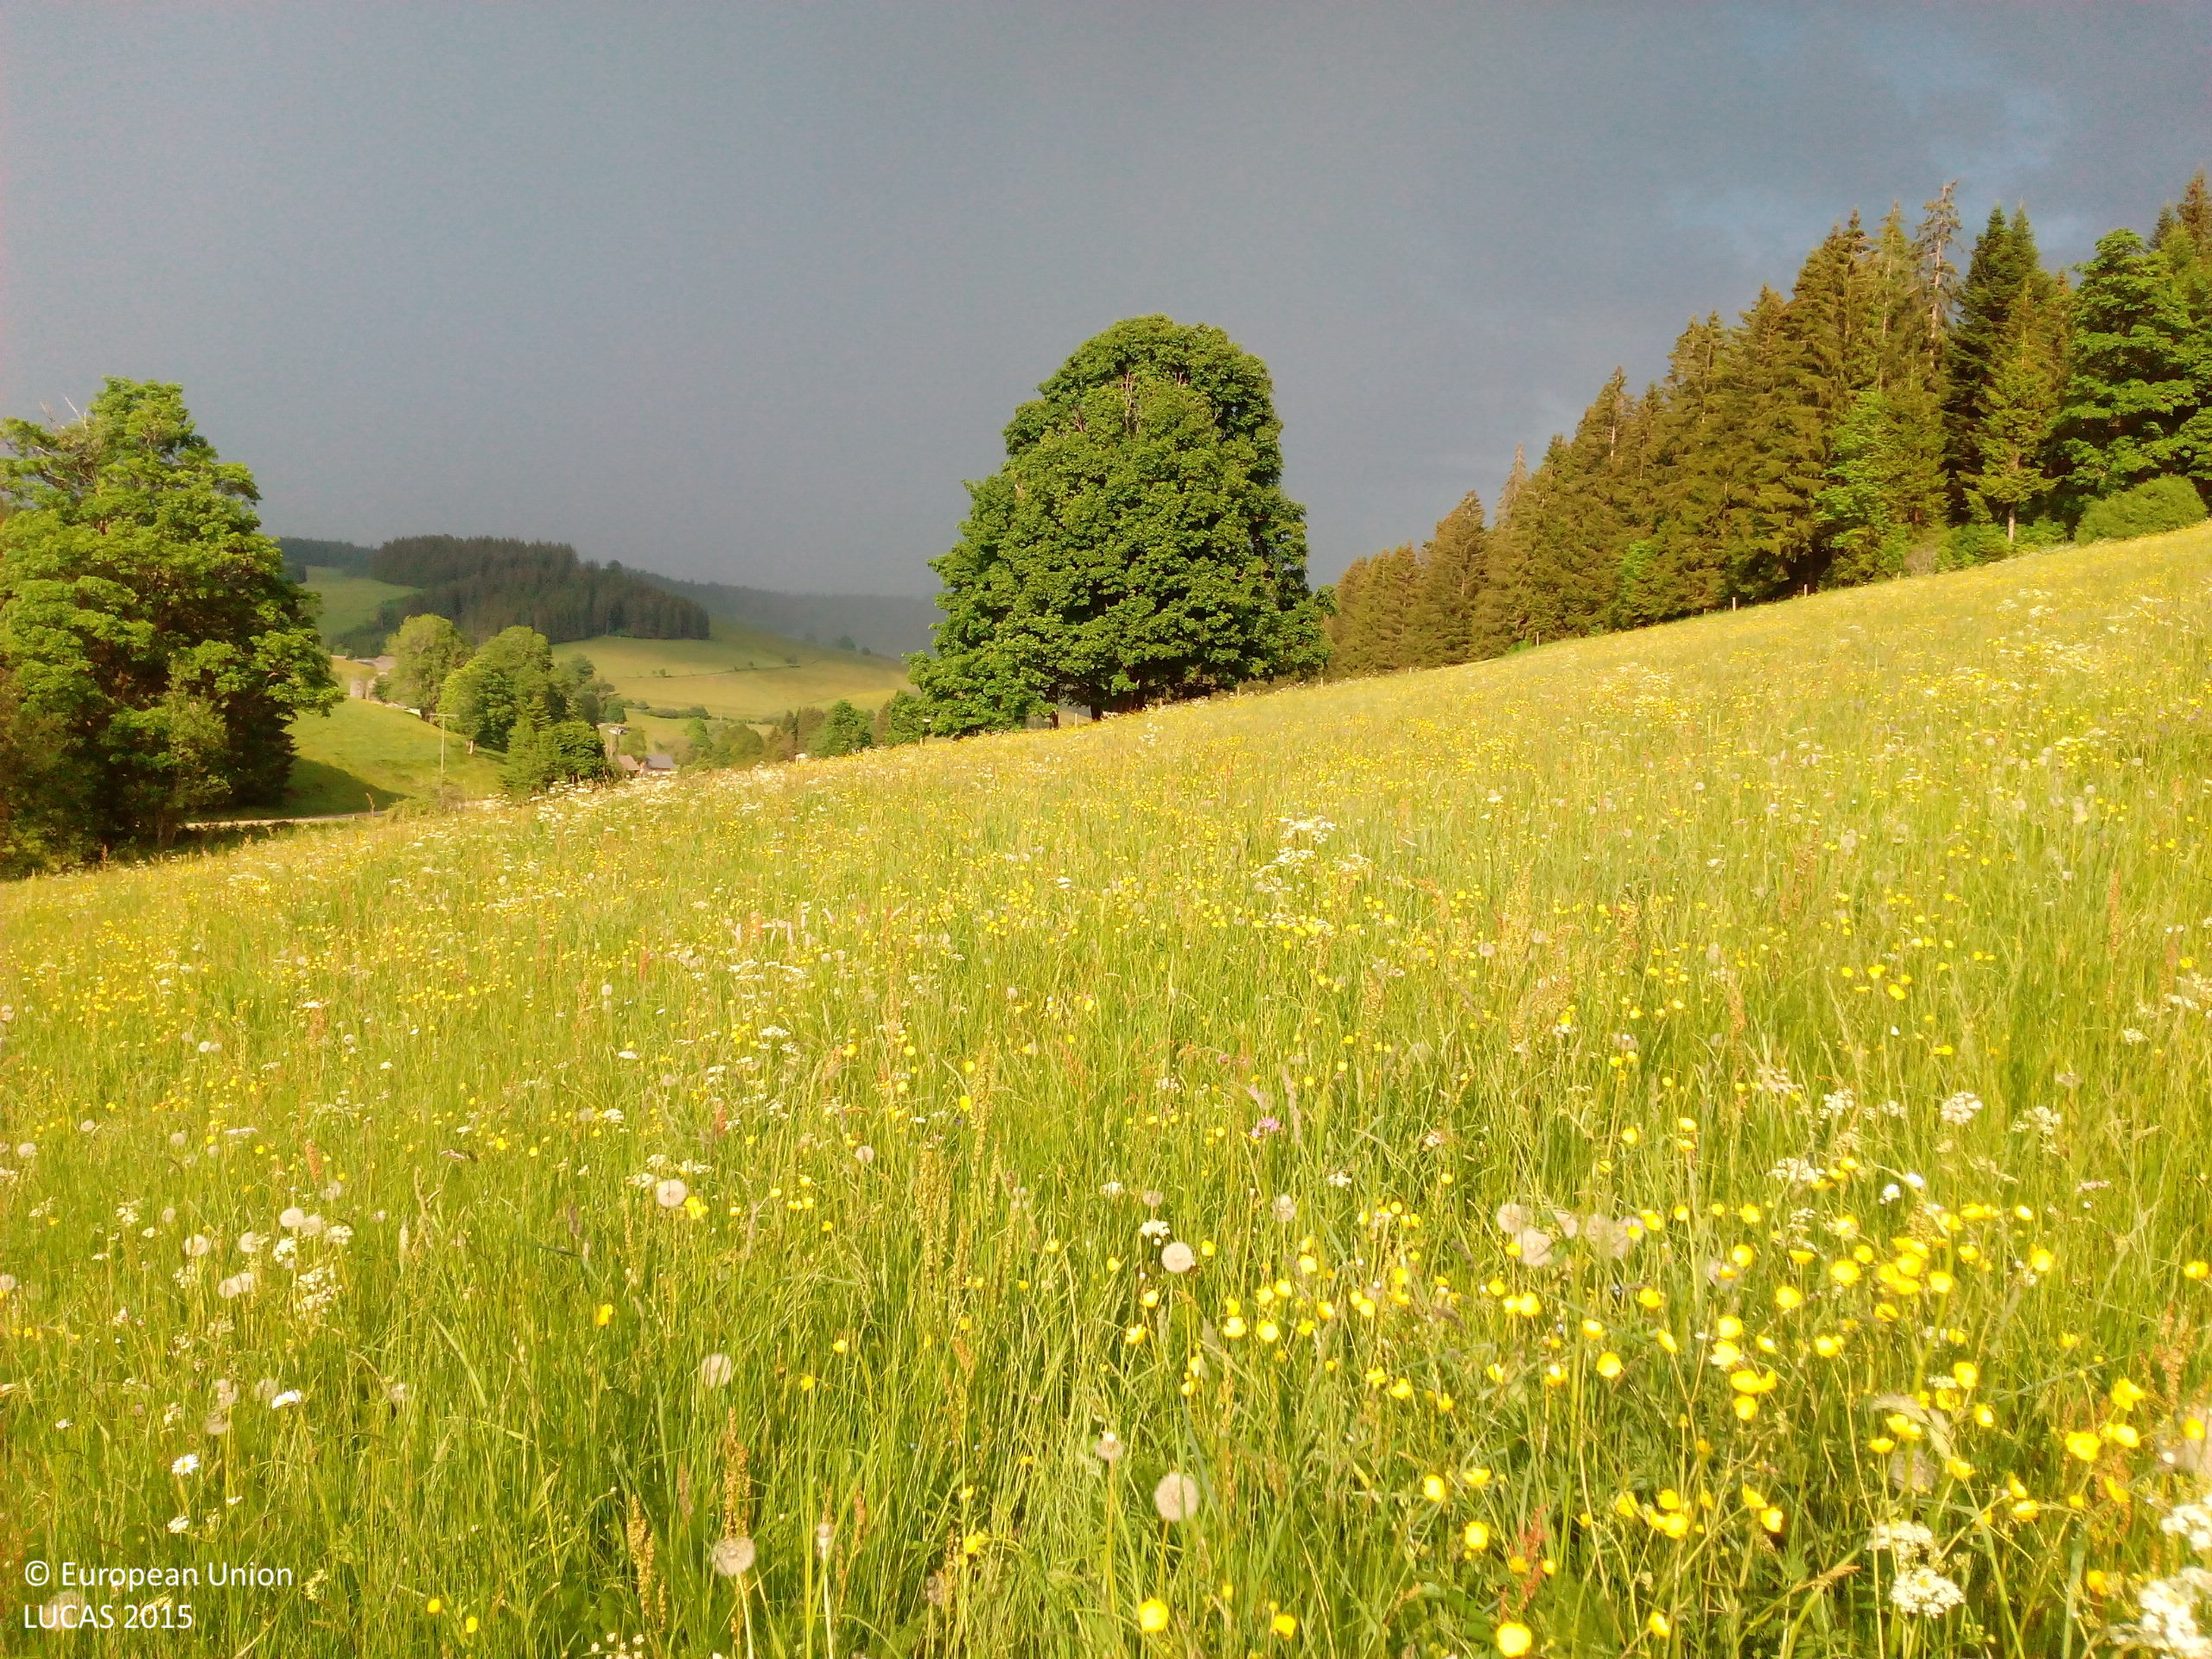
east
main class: Grassland
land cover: Grassland without tree/shrub cover
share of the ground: > 75 %
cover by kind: herbaceous plants 100 %
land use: Agriculture (excluding fallow land and kitchen gardens)
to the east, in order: Grassland without tree/shrub cover; Fences; Grassland without tree/shrub cover; Fences; Groves; Rivers and streams; Spruce dominated coniferous woodland
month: June
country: DE
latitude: 47.9558
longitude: 8.1397
